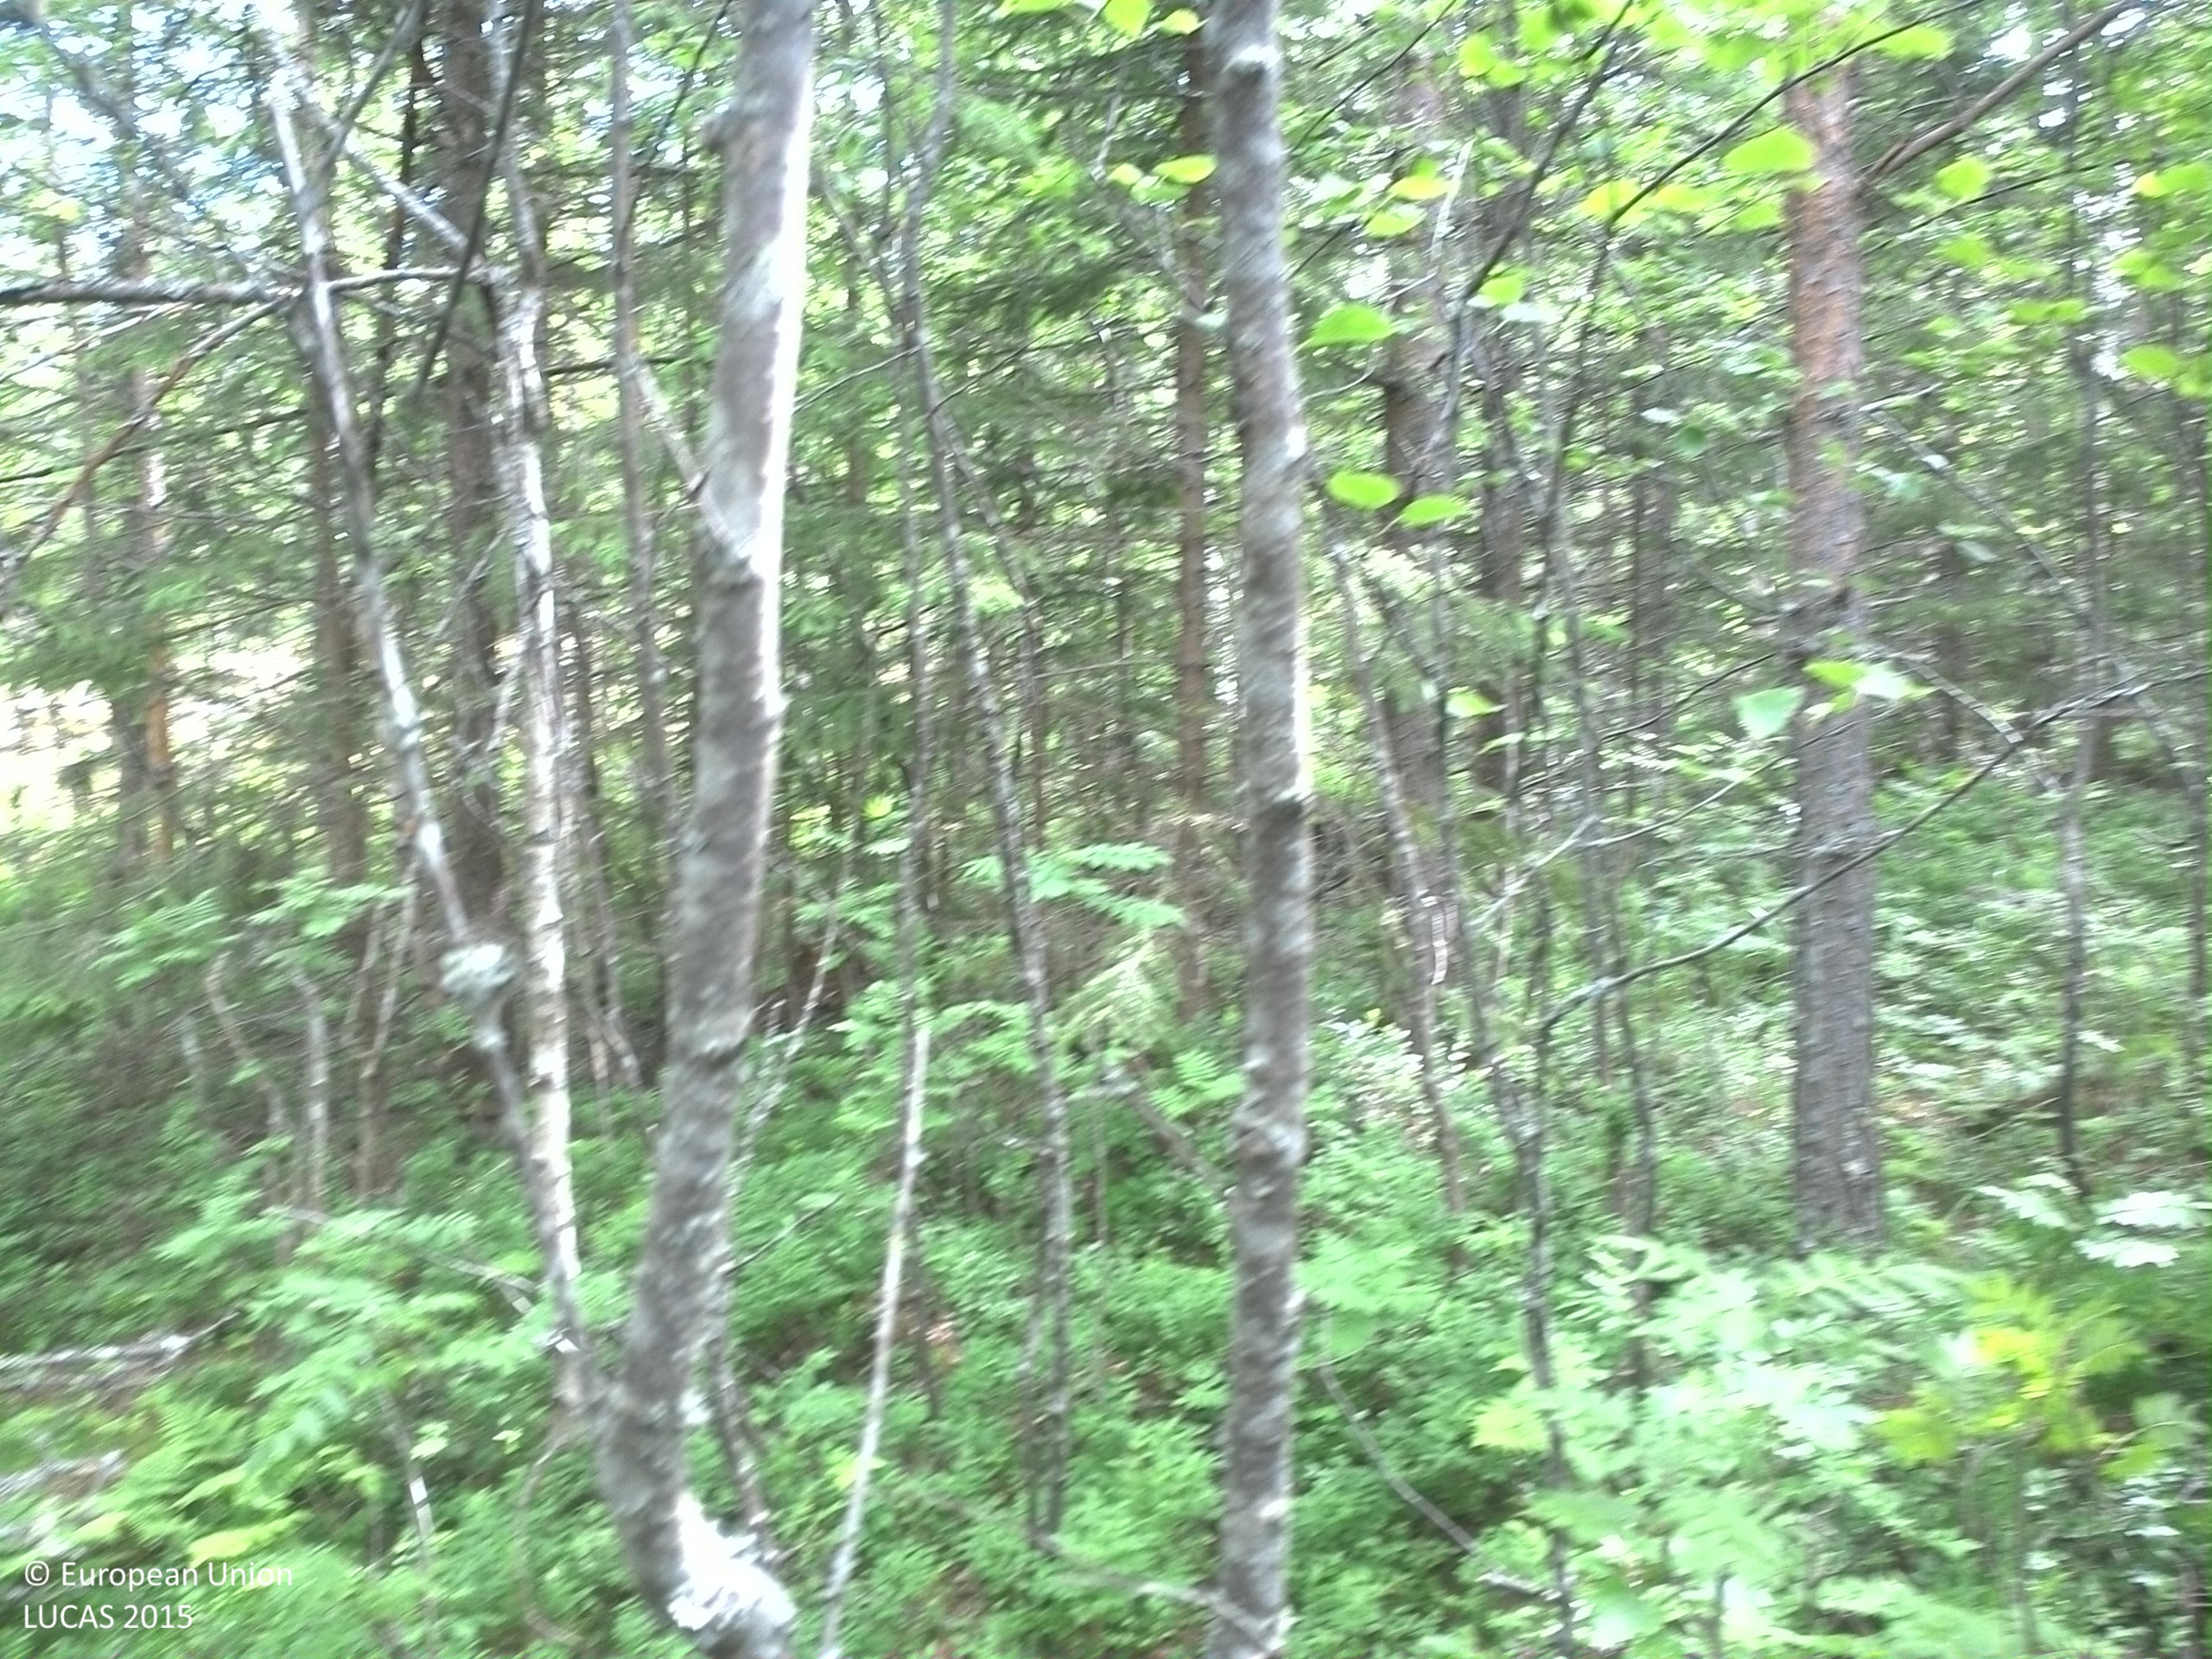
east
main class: Woodland
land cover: Spruce dominated mixed woodland
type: boreal forest
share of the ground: > 75 %
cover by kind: coniferous forest trees 60 %, broadleaved forest trees 20 %, shrubs 20 %
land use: Forestry
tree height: > 5 m
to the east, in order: Spruce dominated mixed woodland; Pine dominated coniferous woodland; Spruce dominated mixed woodland
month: June
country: SE
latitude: 62.8683
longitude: 17.7028
